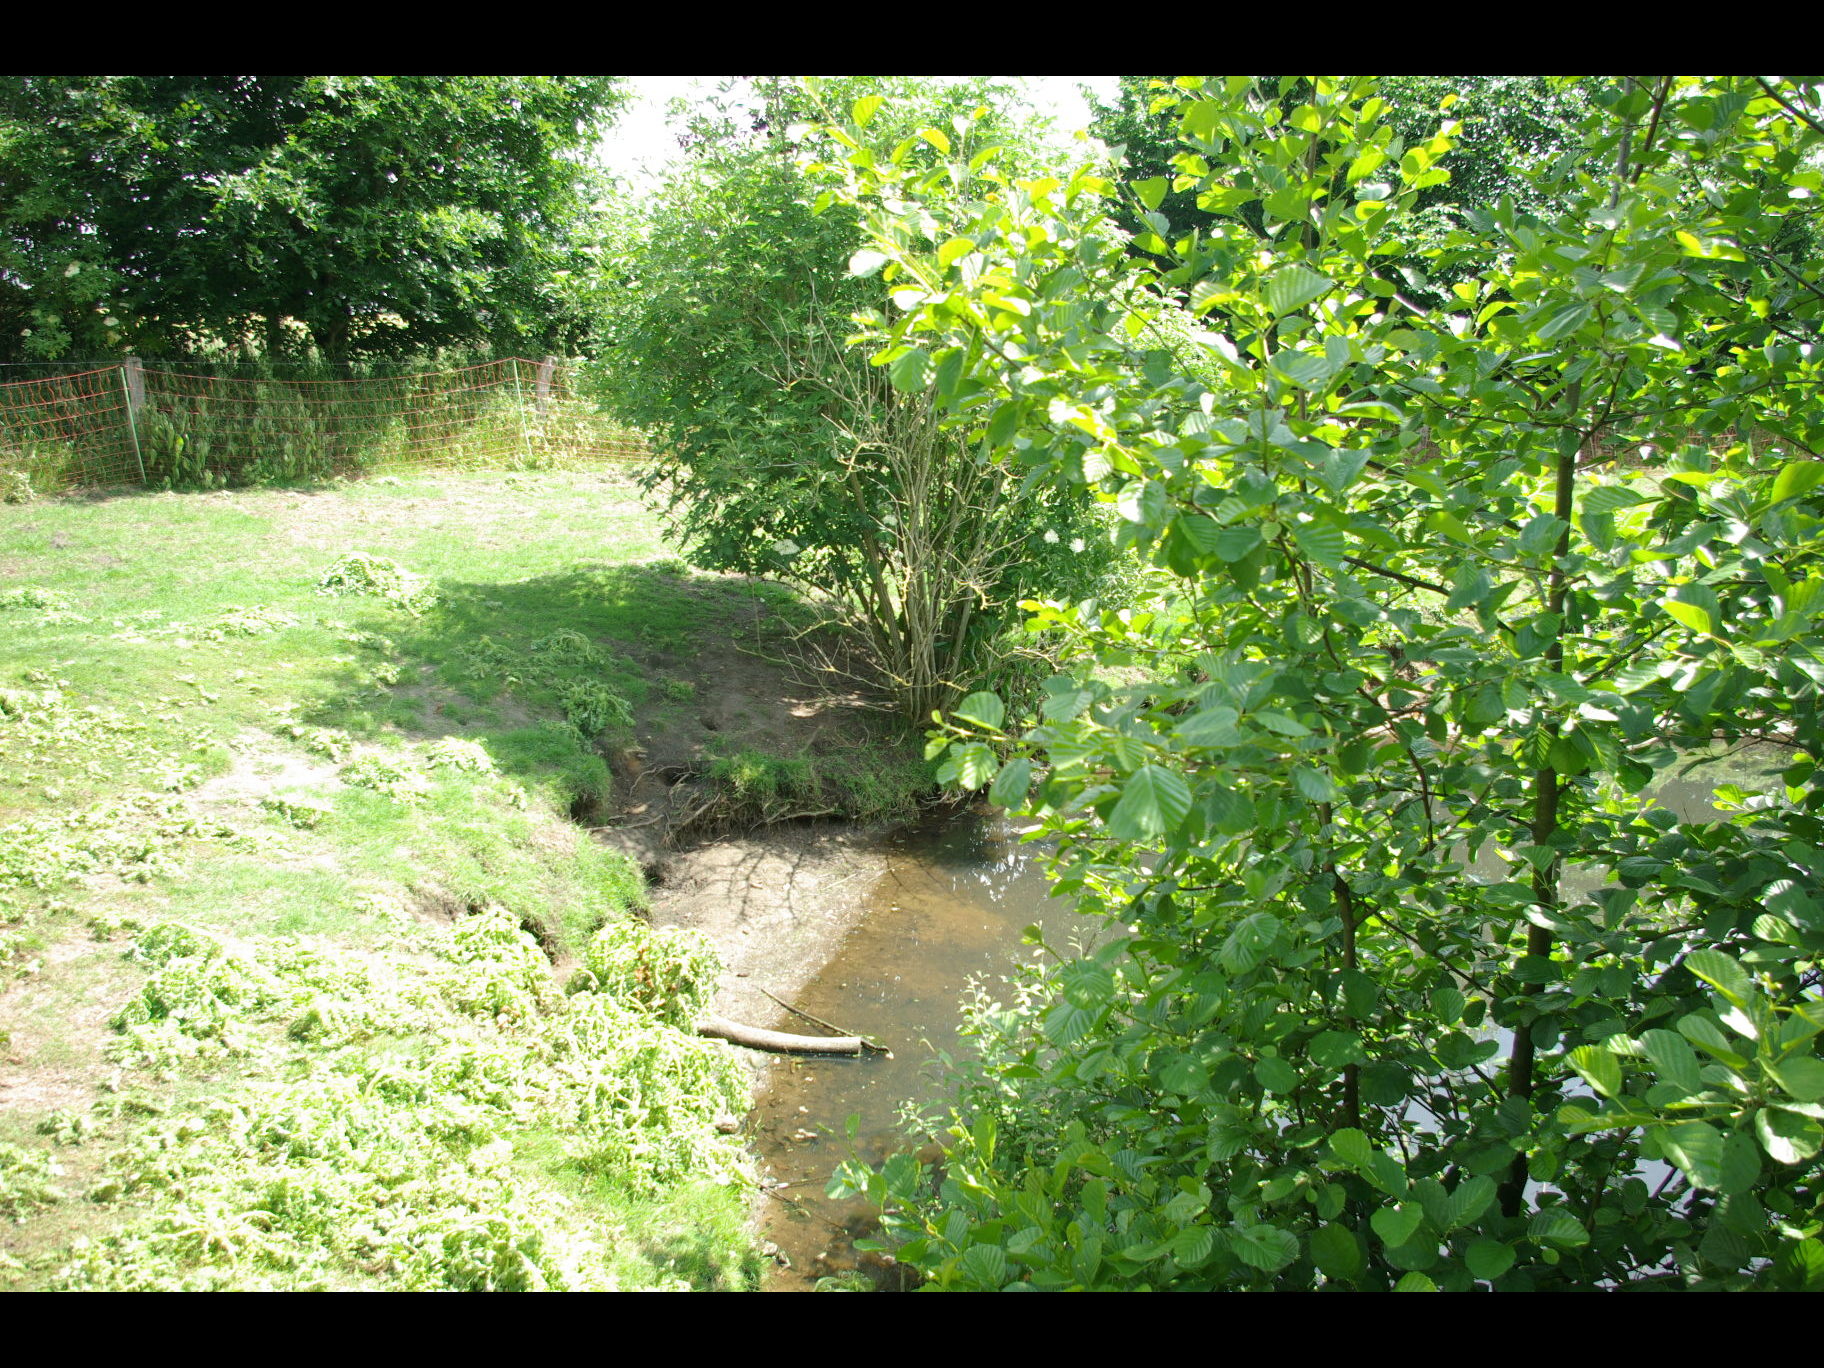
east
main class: Grassland
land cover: Grassland without tree/shrub cover
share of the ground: > 75 %
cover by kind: herbaceous plants 80 %, unconsolidated bare surface 20 %
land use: Agriculture (excluding fallow land and kitchen gardens)
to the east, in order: Grassland without tree/shrub cover; Inland fresh running water; Single bushes/trees; Grassland without tree/shrub cover; Fences; Broadleaved woodland; Fences; Grassland without tree/shrub cover; Fences; Barley
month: June
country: DE
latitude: 54.0848
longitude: 9.8931
